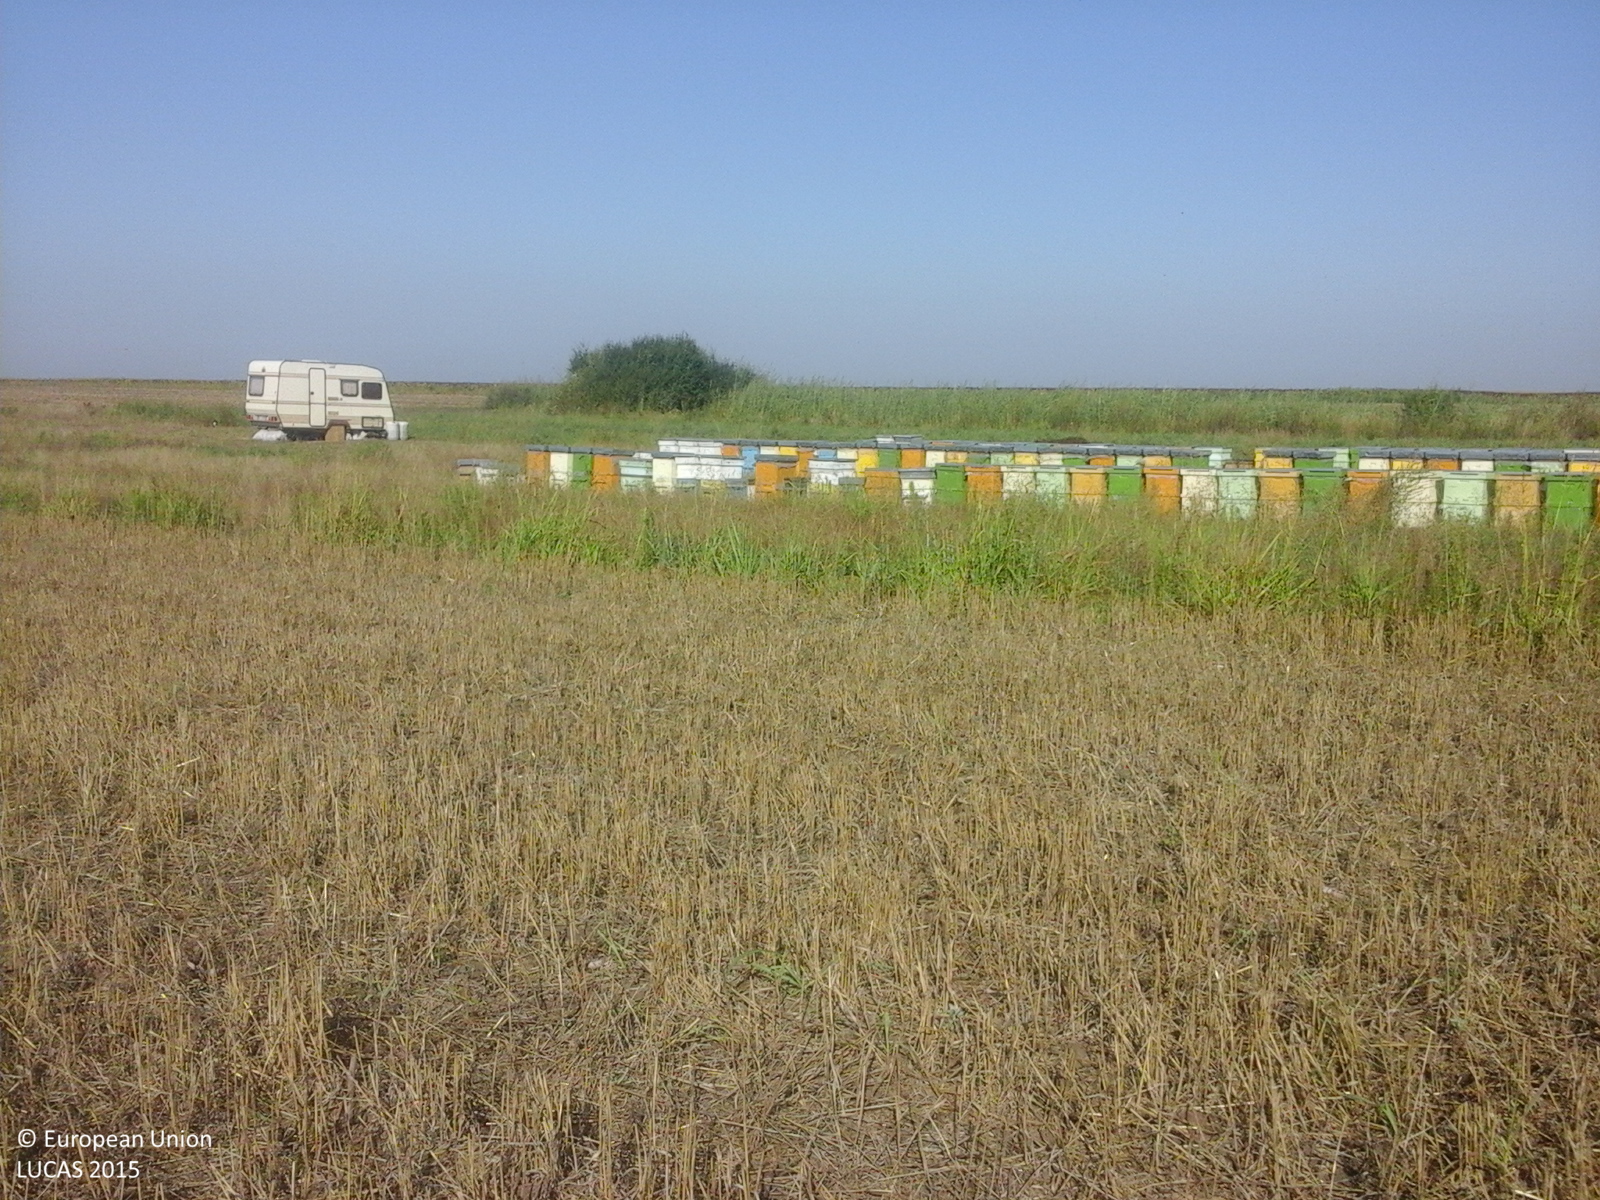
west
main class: Cropland
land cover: Common wheat
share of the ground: > 75 %
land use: Agriculture (excluding fallow land and kitchen gardens)
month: August
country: RO
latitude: 45.7518
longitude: 20.9413
